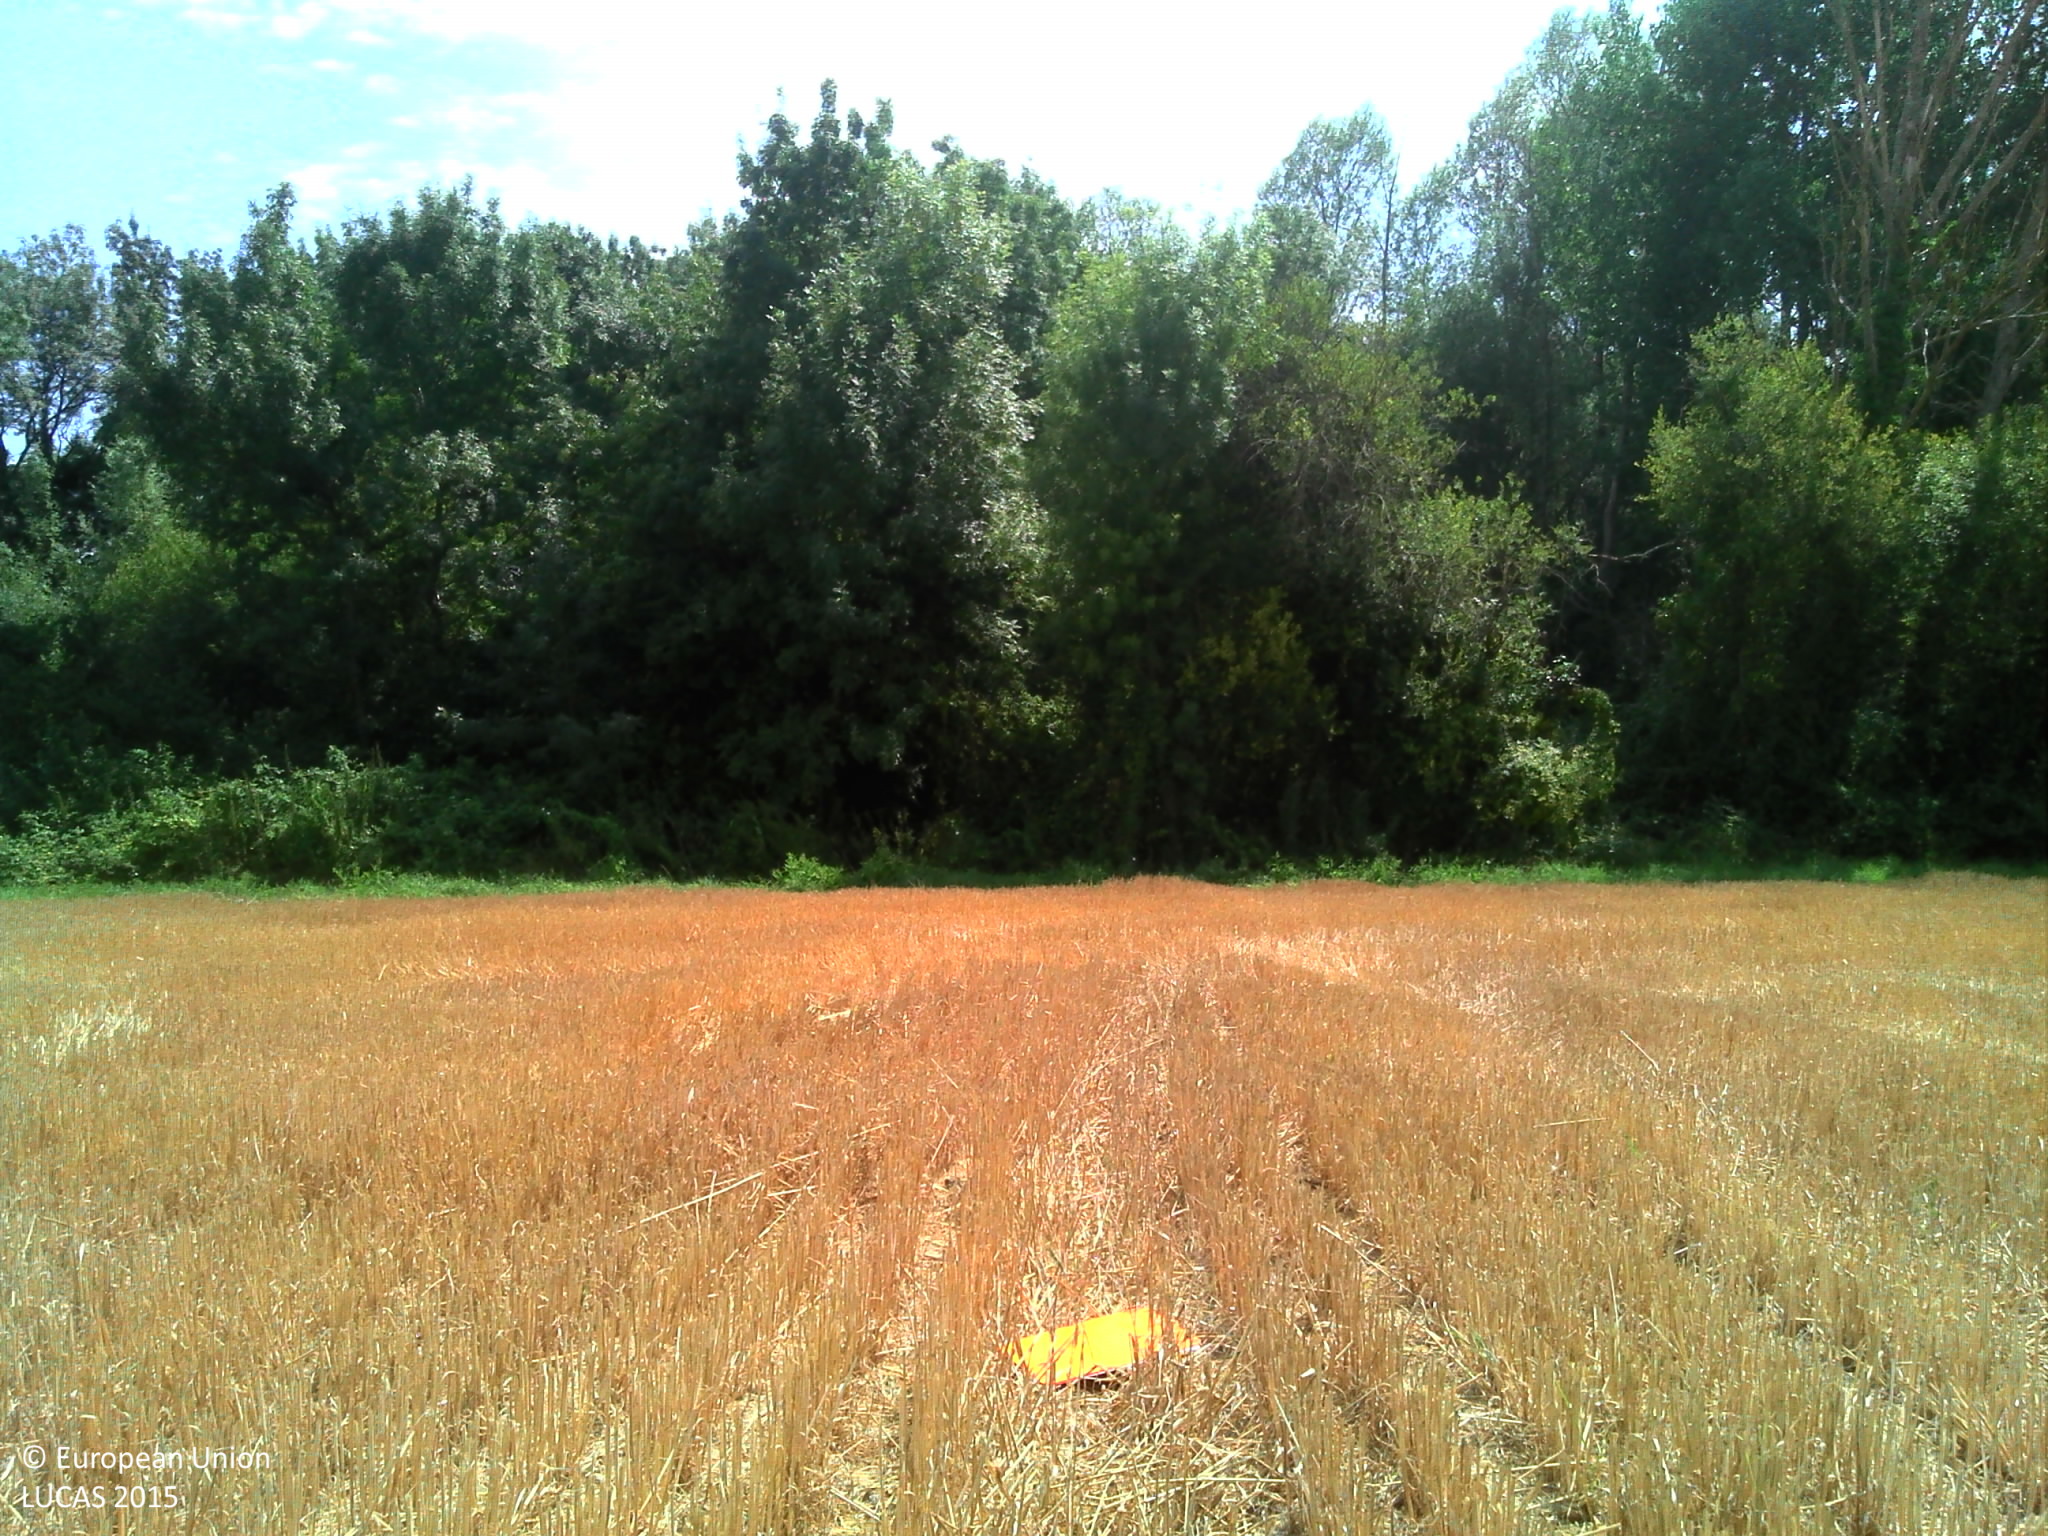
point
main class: Cropland
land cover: Common wheat
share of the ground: > 75 %
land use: Agriculture (excluding fallow land and kitchen gardens)
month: August
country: FR
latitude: 47.1293
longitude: 0.1557
